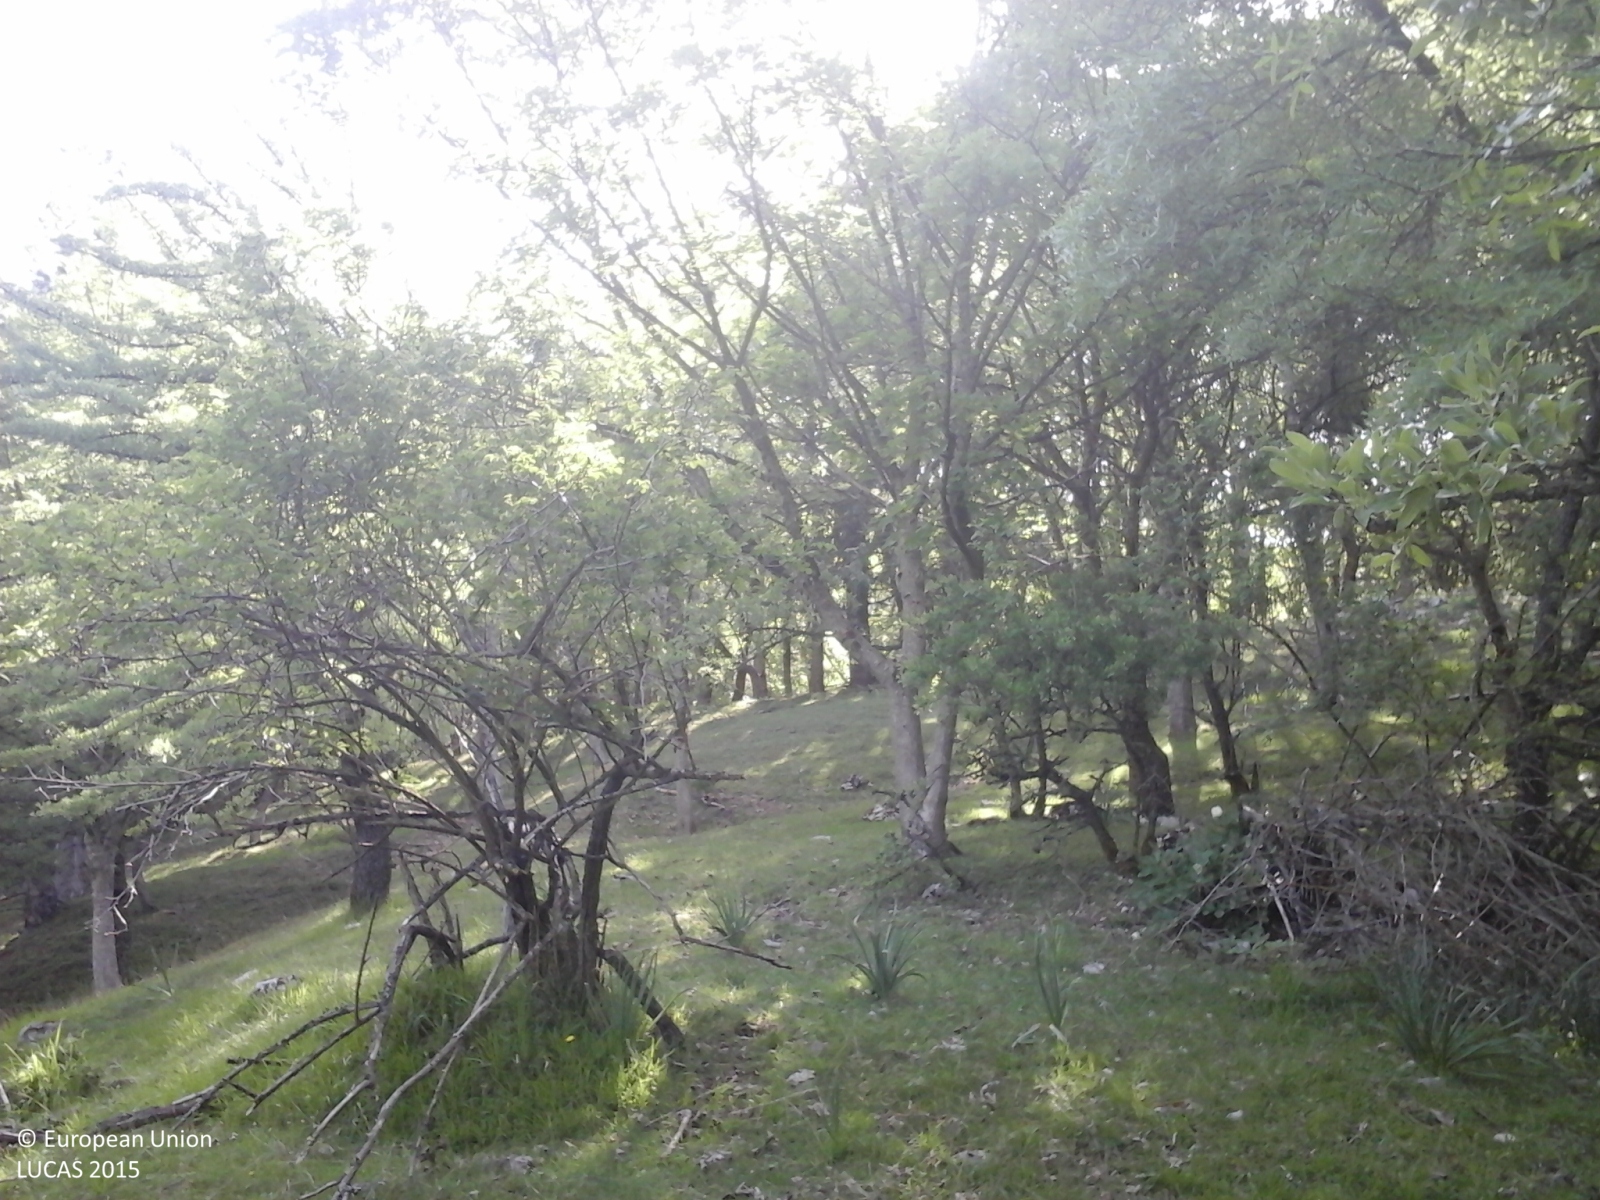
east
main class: Woodland
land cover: Broadleaved woodland
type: thermophilous deciduous forest
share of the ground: > 75 %
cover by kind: broadleaved forest trees 80 %, herbaceous plants 10 %, shrubs 5 %, consolidated bare surface 5 %
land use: Forestry
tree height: > 5 m
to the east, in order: Broadleaved woodland; Rocks and stones; Broadleaved woodland; Fences; Tracks; Other coniferous woodland; Rocks and stones; Tracks; Grassland with sparse tree/shrub cover; Dry stone walls; Tracks; Rocks and stones
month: May
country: IT
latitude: 37.8811
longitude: 14.0078
